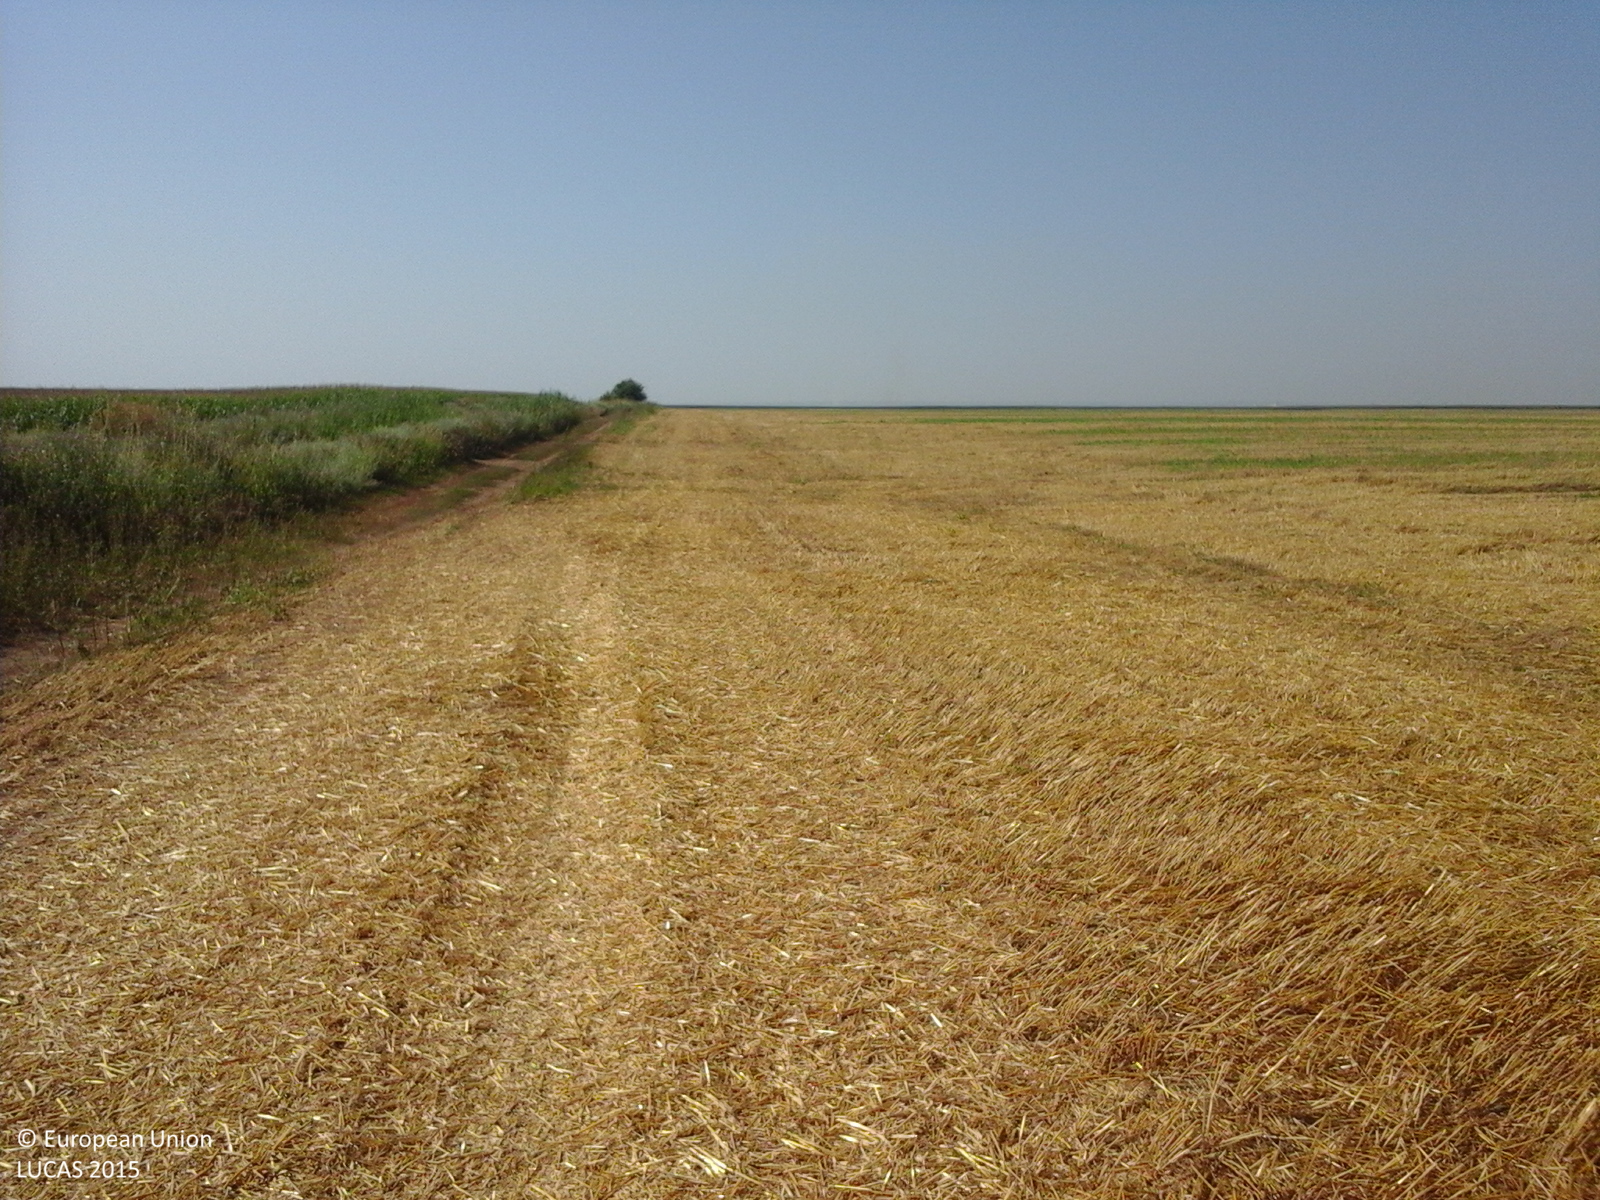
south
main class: Cropland
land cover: Common wheat
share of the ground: 10 - 25 %
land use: Agriculture (excluding fallow land and kitchen gardens)
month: July
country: RO
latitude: 44.3035
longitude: 27.3984
